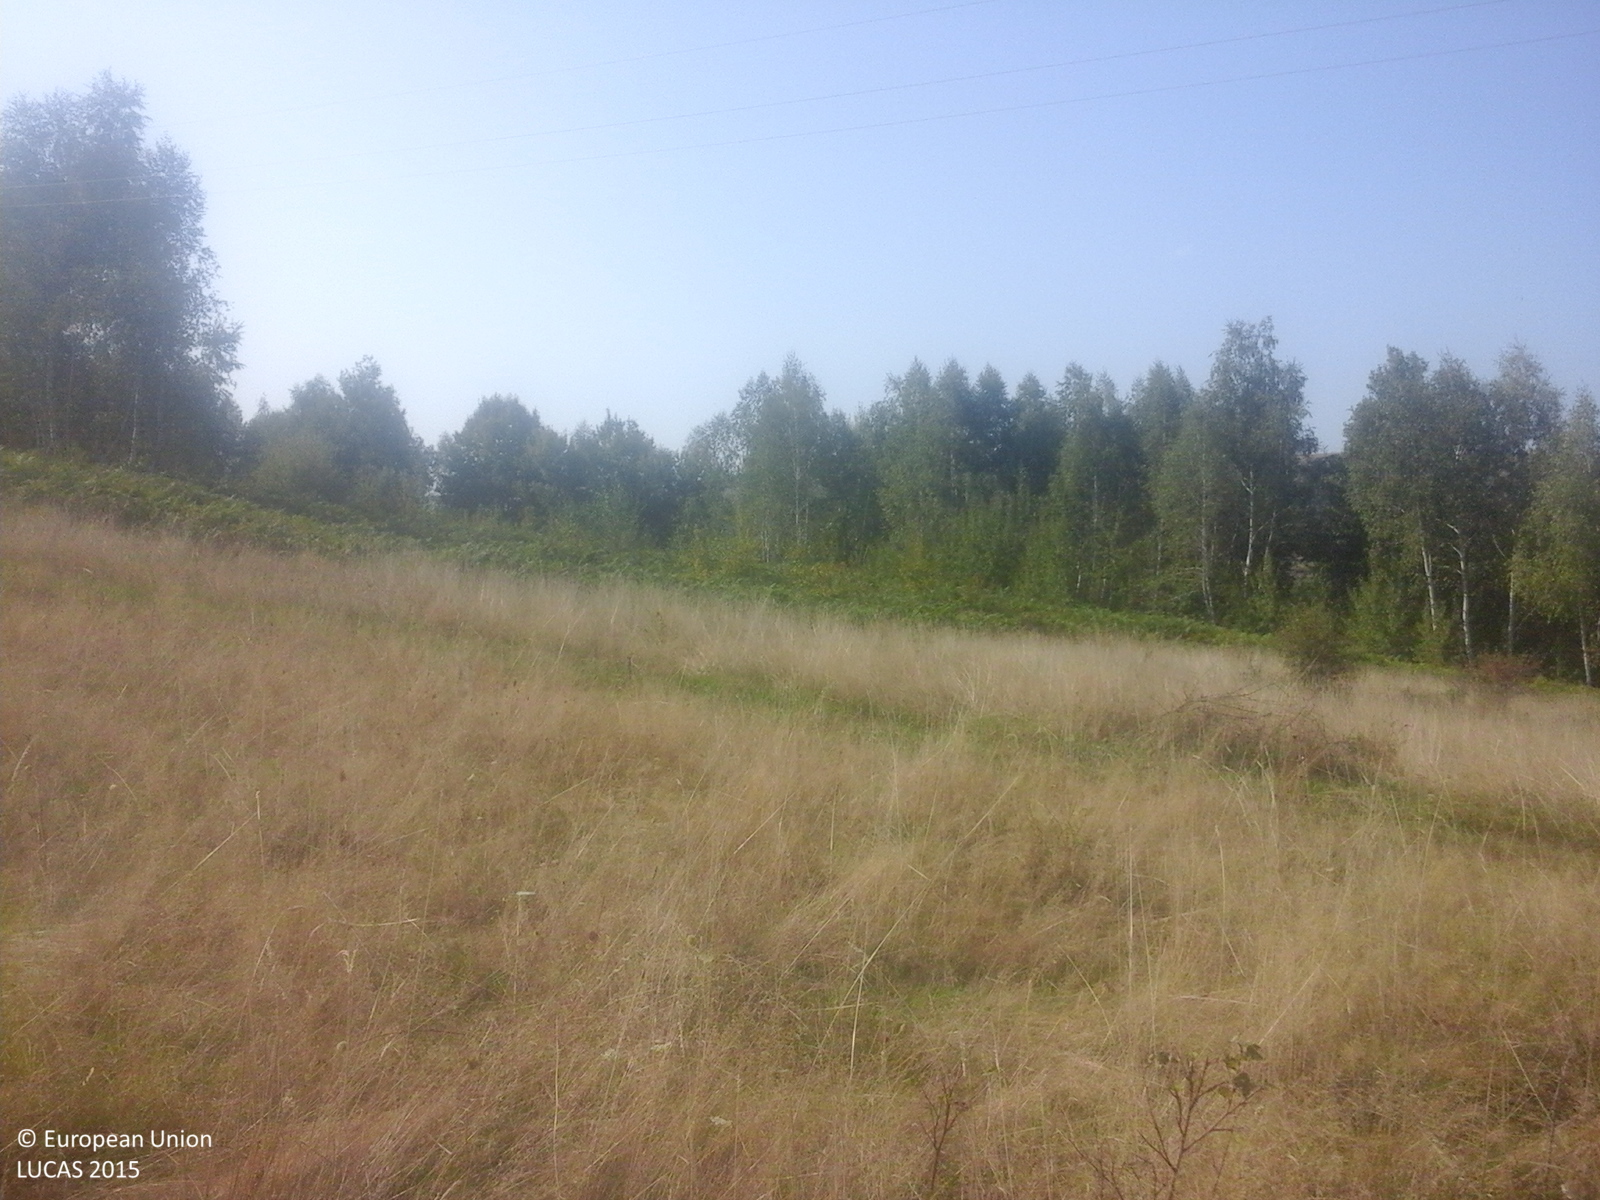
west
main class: Grassland
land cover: Grassland with sparse tree/shrub cover
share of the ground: > 75 %
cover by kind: herbaceous plants 85 %, shrubs 10 %, broadleaved forest trees 5 %
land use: Agriculture (excluding fallow land and kitchen gardens)
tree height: < 5 m
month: September
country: RO
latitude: 45.8514
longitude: 22.5006
